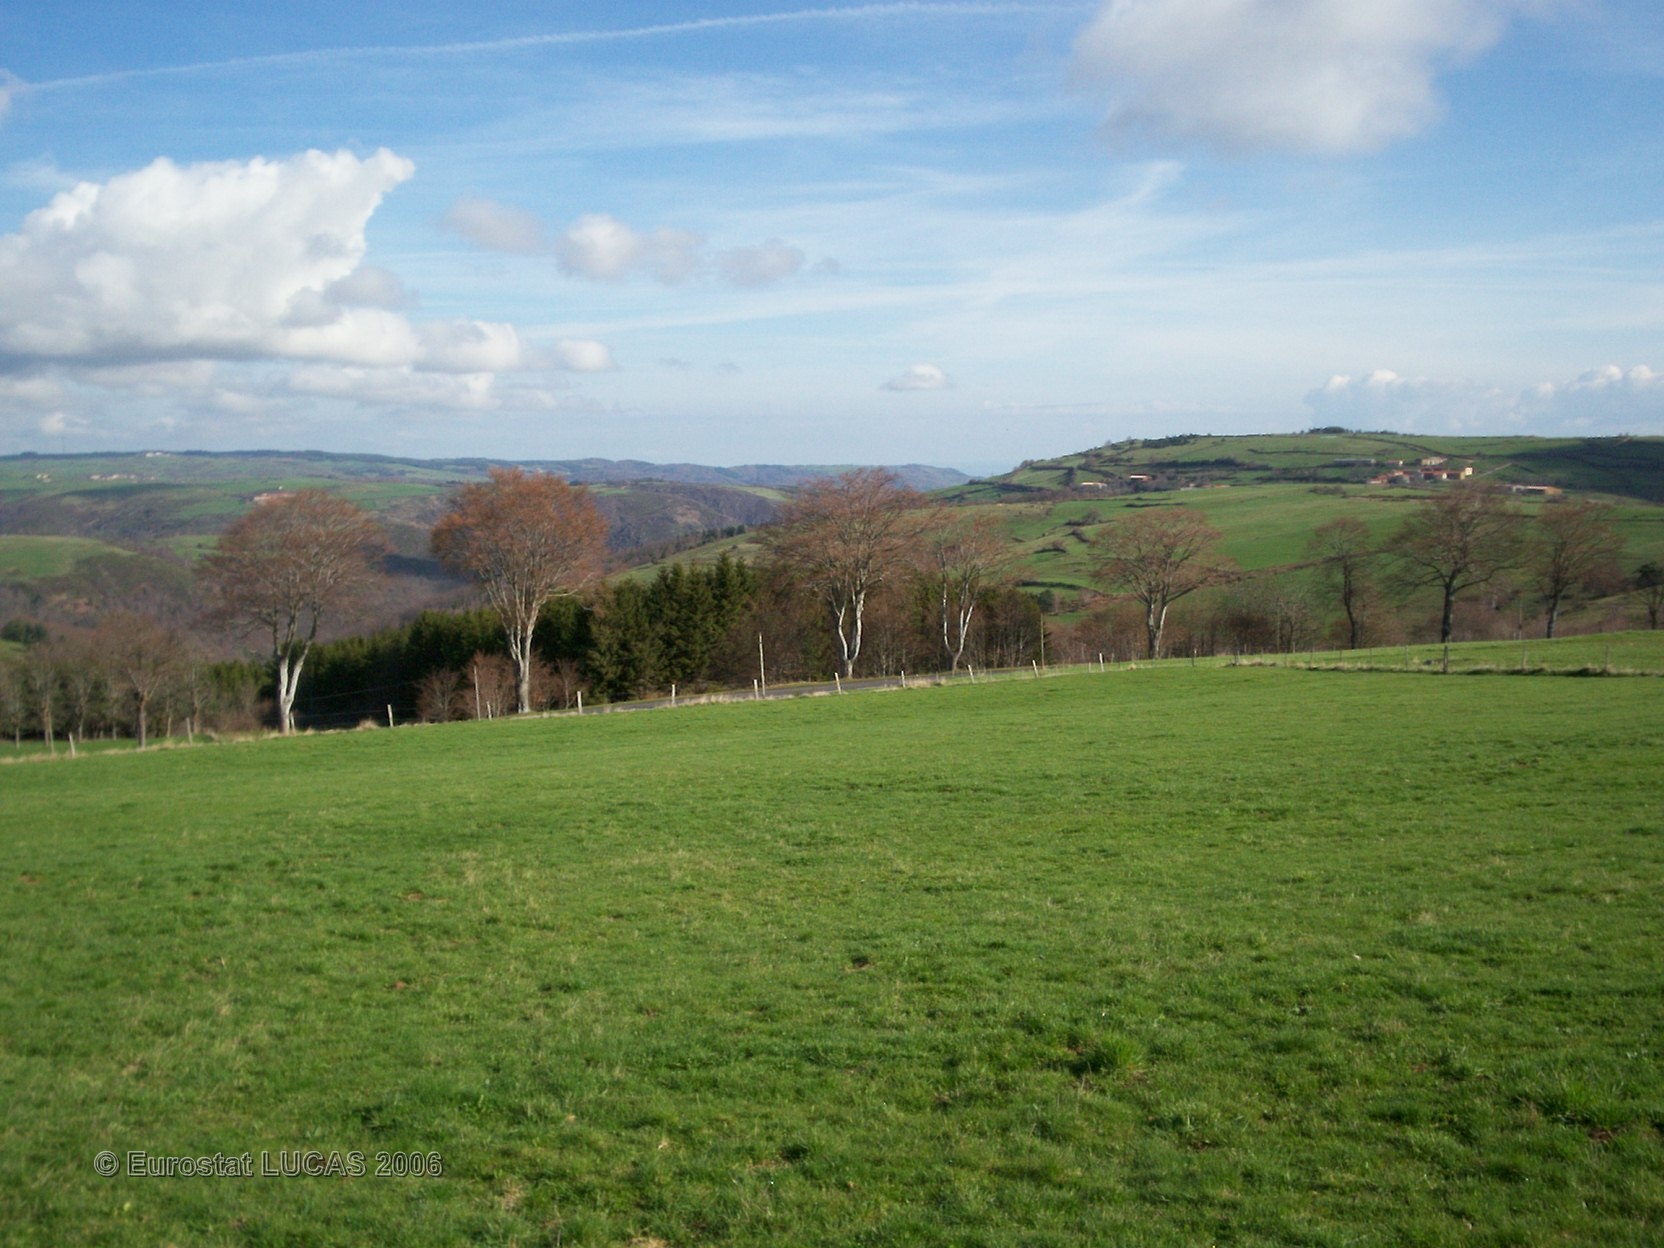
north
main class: Grassland
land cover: Grassland without tree/shrub cover
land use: Agriculture (excluding fallow land and kitchen gardens)
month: April
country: FR
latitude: 45.0603
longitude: 3.3612
